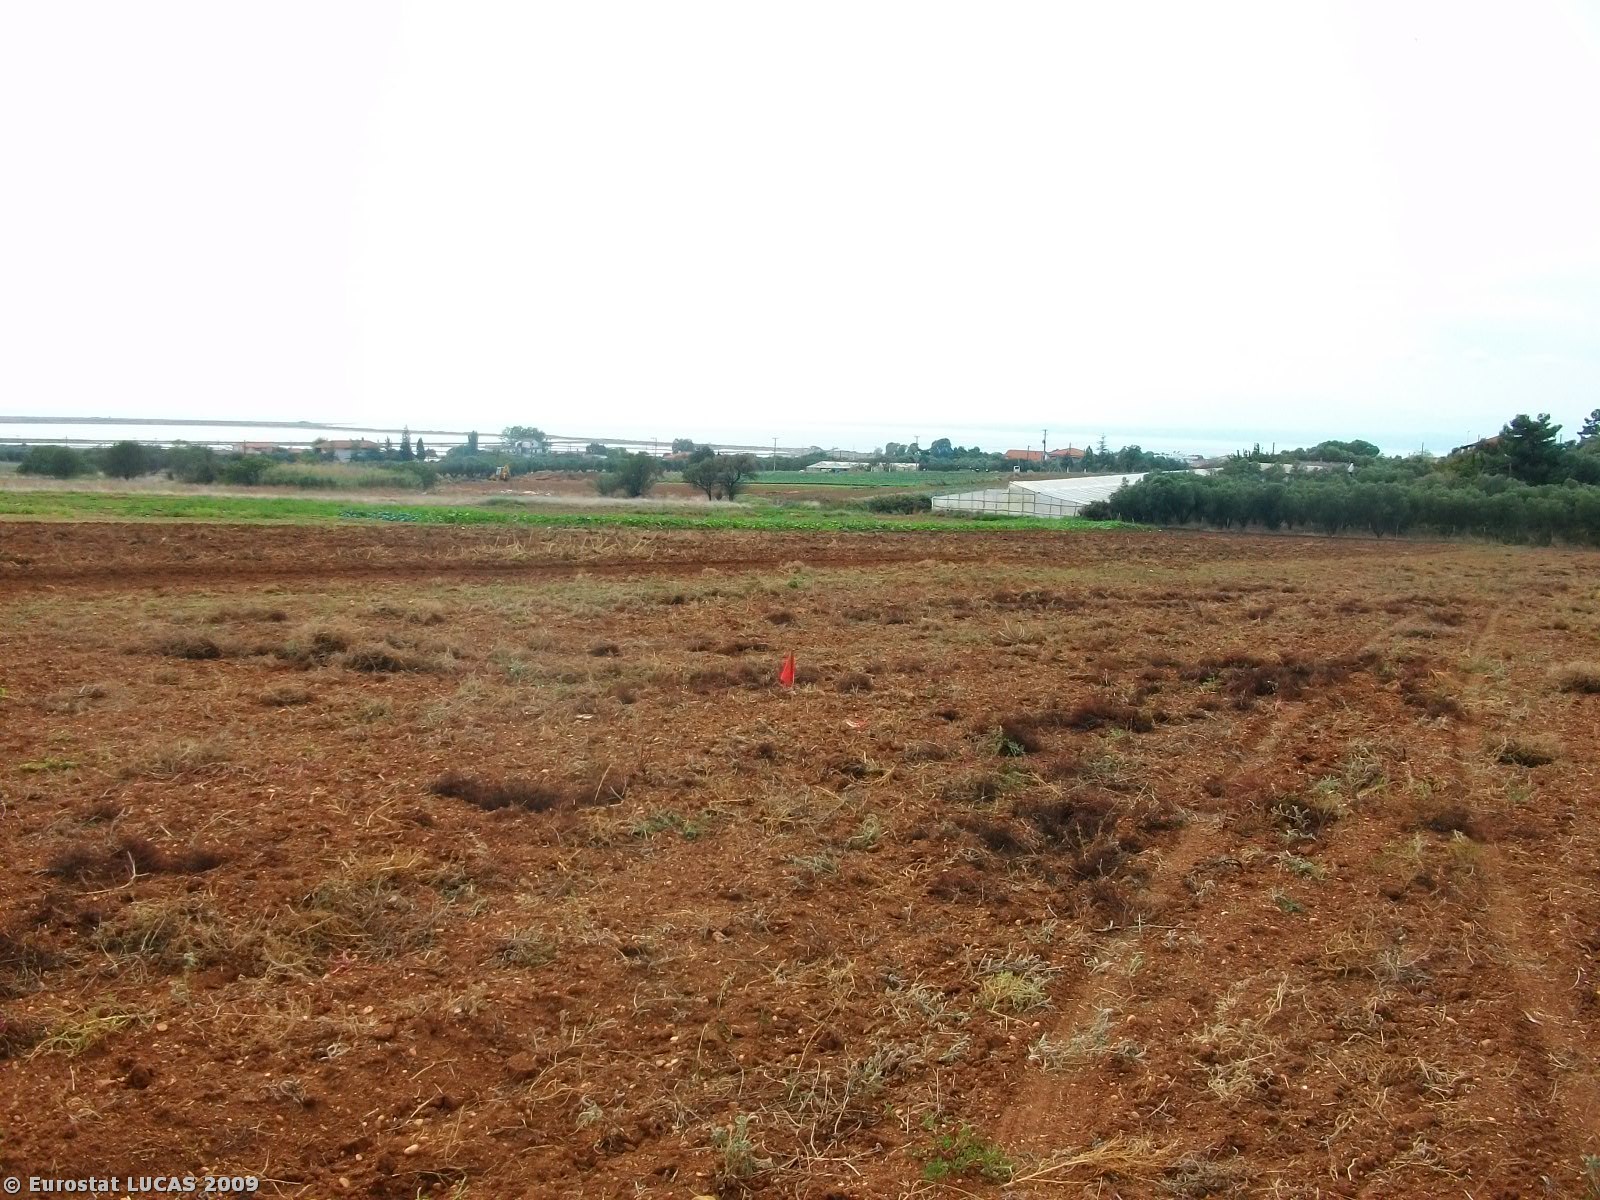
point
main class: Cropland
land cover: Common wheat
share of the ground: < 10 %
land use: Agriculture (excluding fallow land and kitchen gardens)
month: September
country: GR
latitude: 40.5002
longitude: 22.8307
